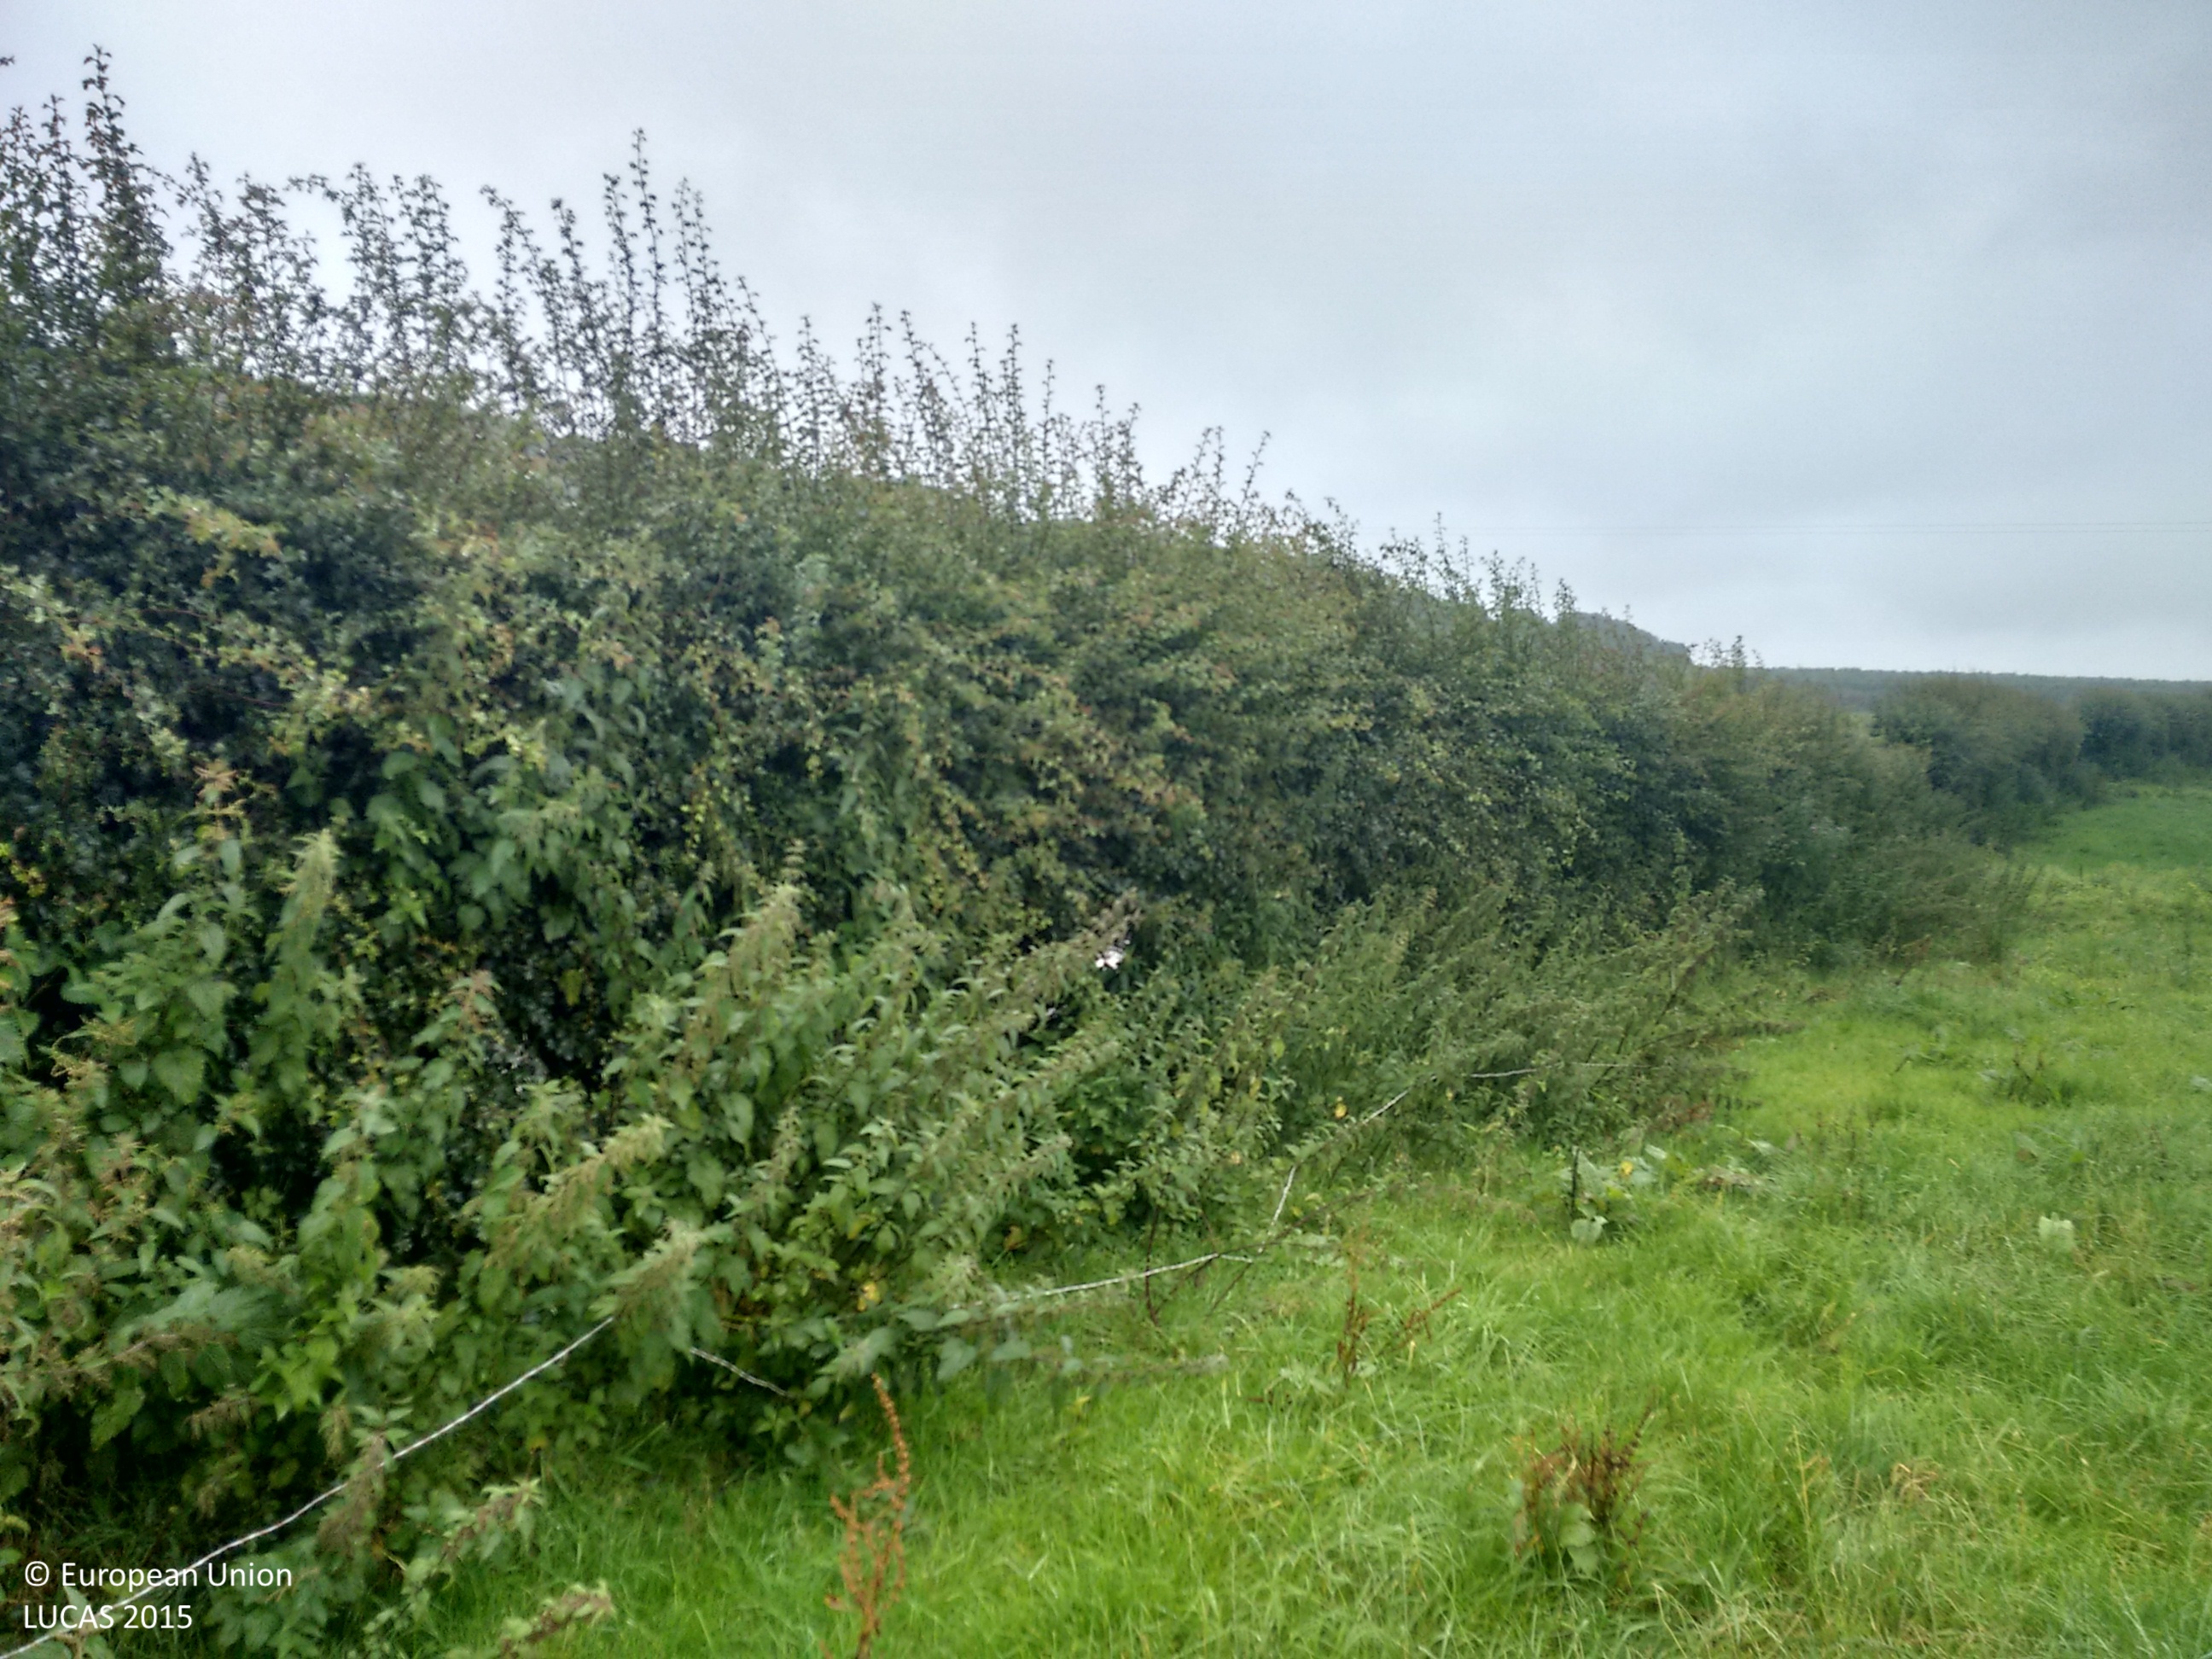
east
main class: Grassland
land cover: Grassland without tree/shrub cover
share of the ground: > 75 %
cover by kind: herbaceous plants 95 %, shrubs 5 %
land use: Agriculture (excluding fallow land and kitchen gardens)
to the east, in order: Grassland without tree/shrub cover; Managed hedges; Fences; Tracks; Grass margins; Fences; Grassland without tree/shrub cover; Fences; Grassland without tree/shrub cover; Electric lines; Grassland without tree/shrub cover; Fences; Tracks; Fences; Grassland without tree/shrub cover
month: August
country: IE
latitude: 52.2487
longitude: -9.4329
